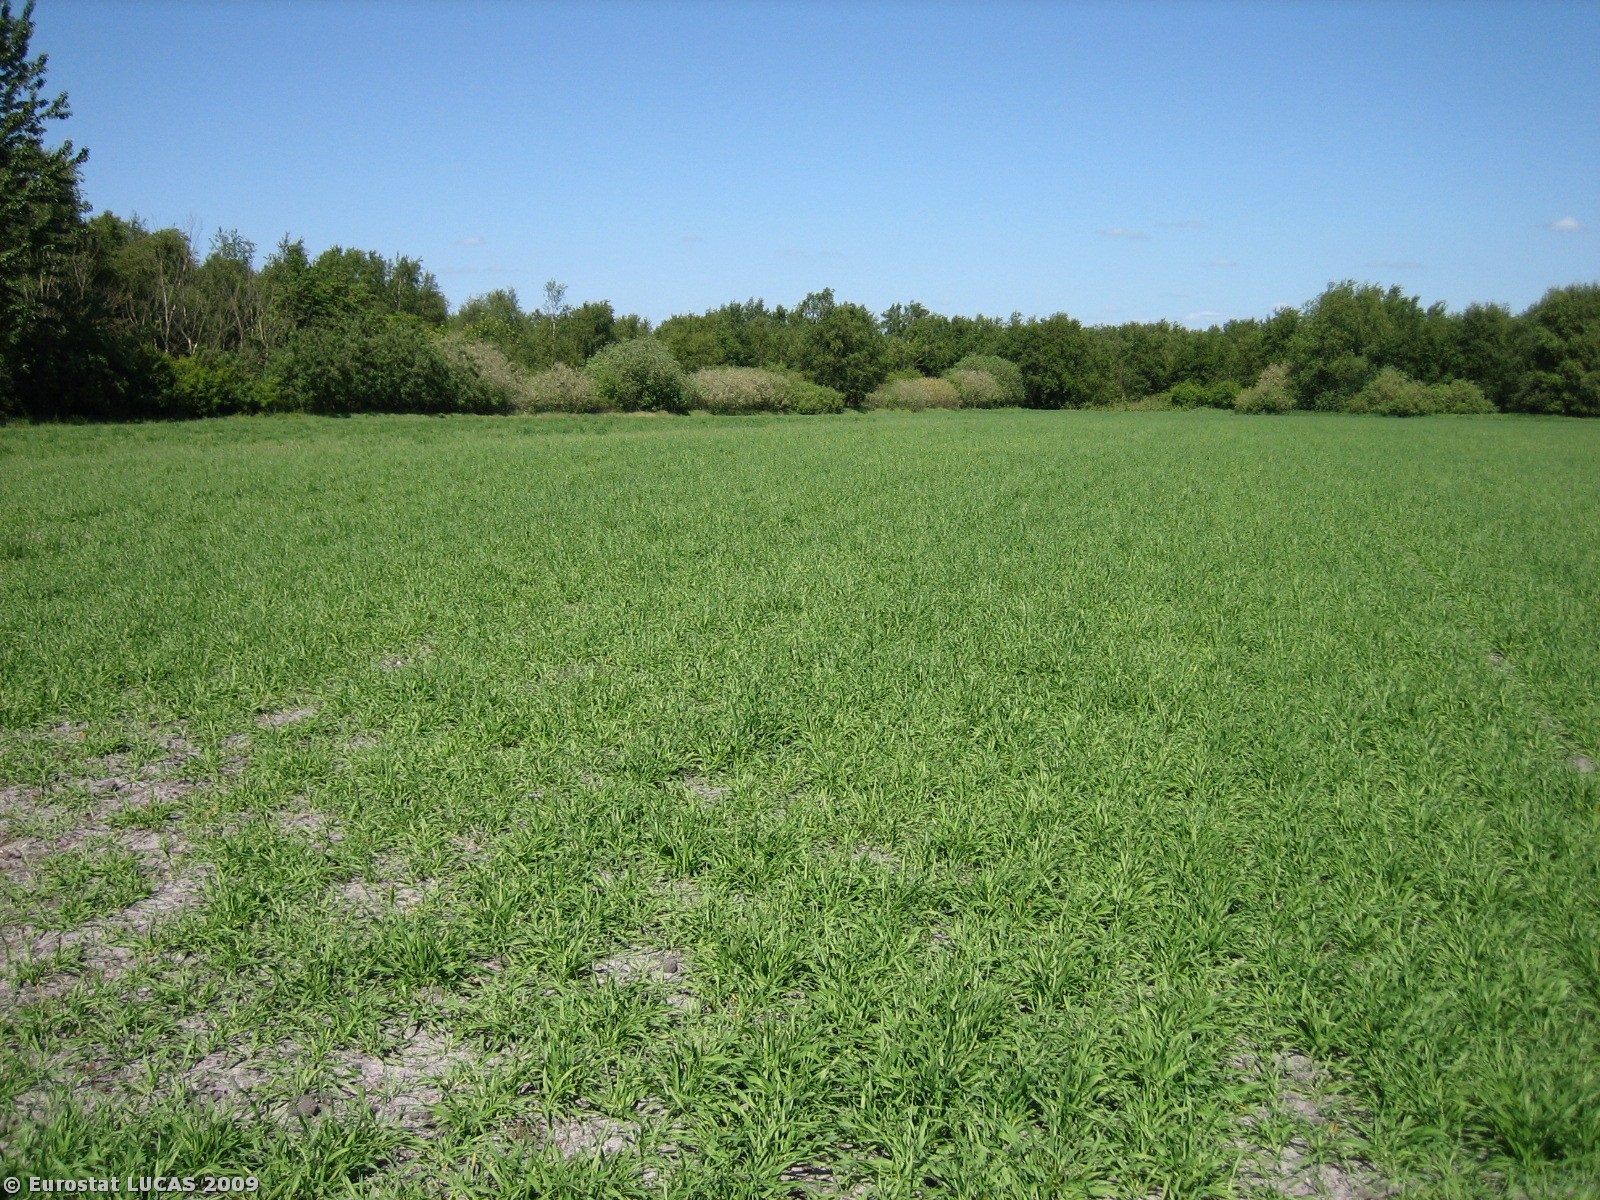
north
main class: Cropland
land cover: Barley
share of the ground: 50 - 75 %
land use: Agriculture (excluding fallow land and kitchen gardens)
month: May
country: DK
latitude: 55.8951
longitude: 8.8658
